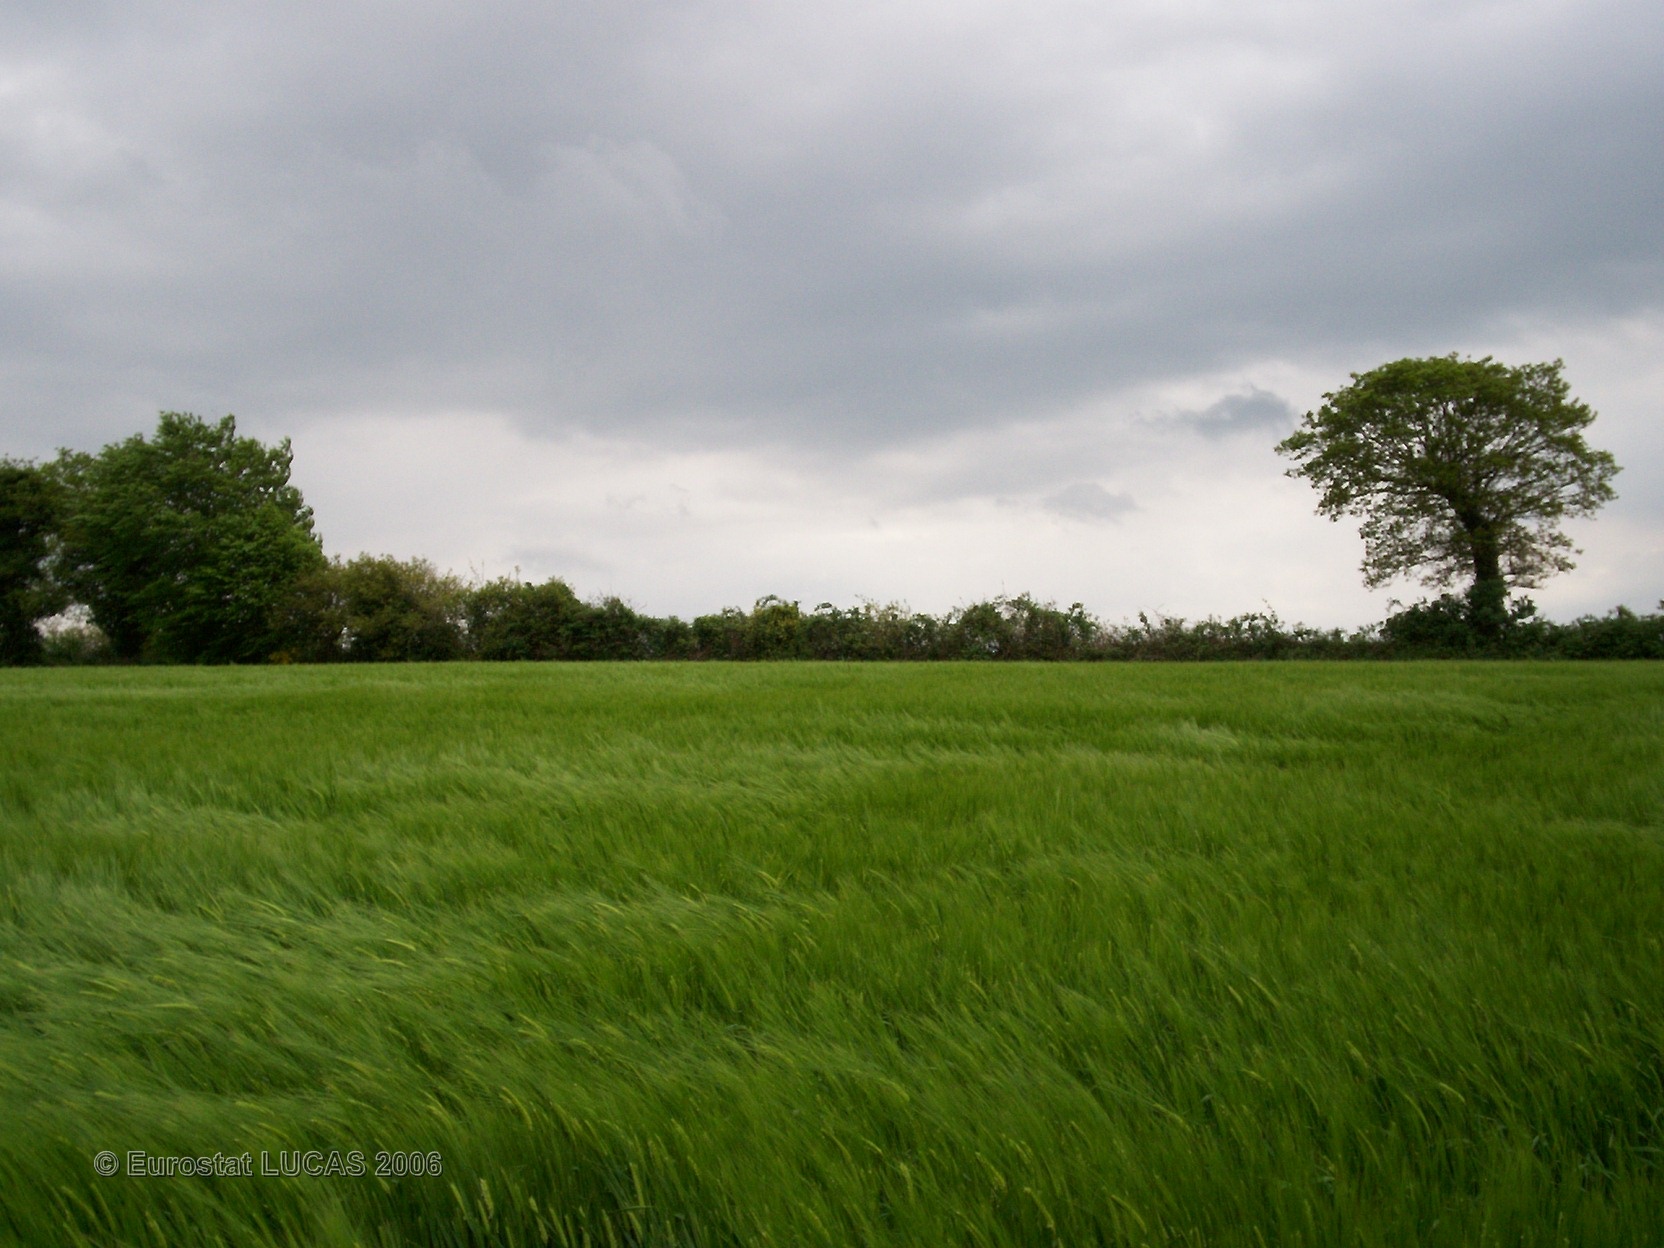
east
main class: Cropland
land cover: Barley
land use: Agriculture (excluding fallow land and kitchen gardens)
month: May
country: FR
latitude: 48.2927
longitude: -3.7092
